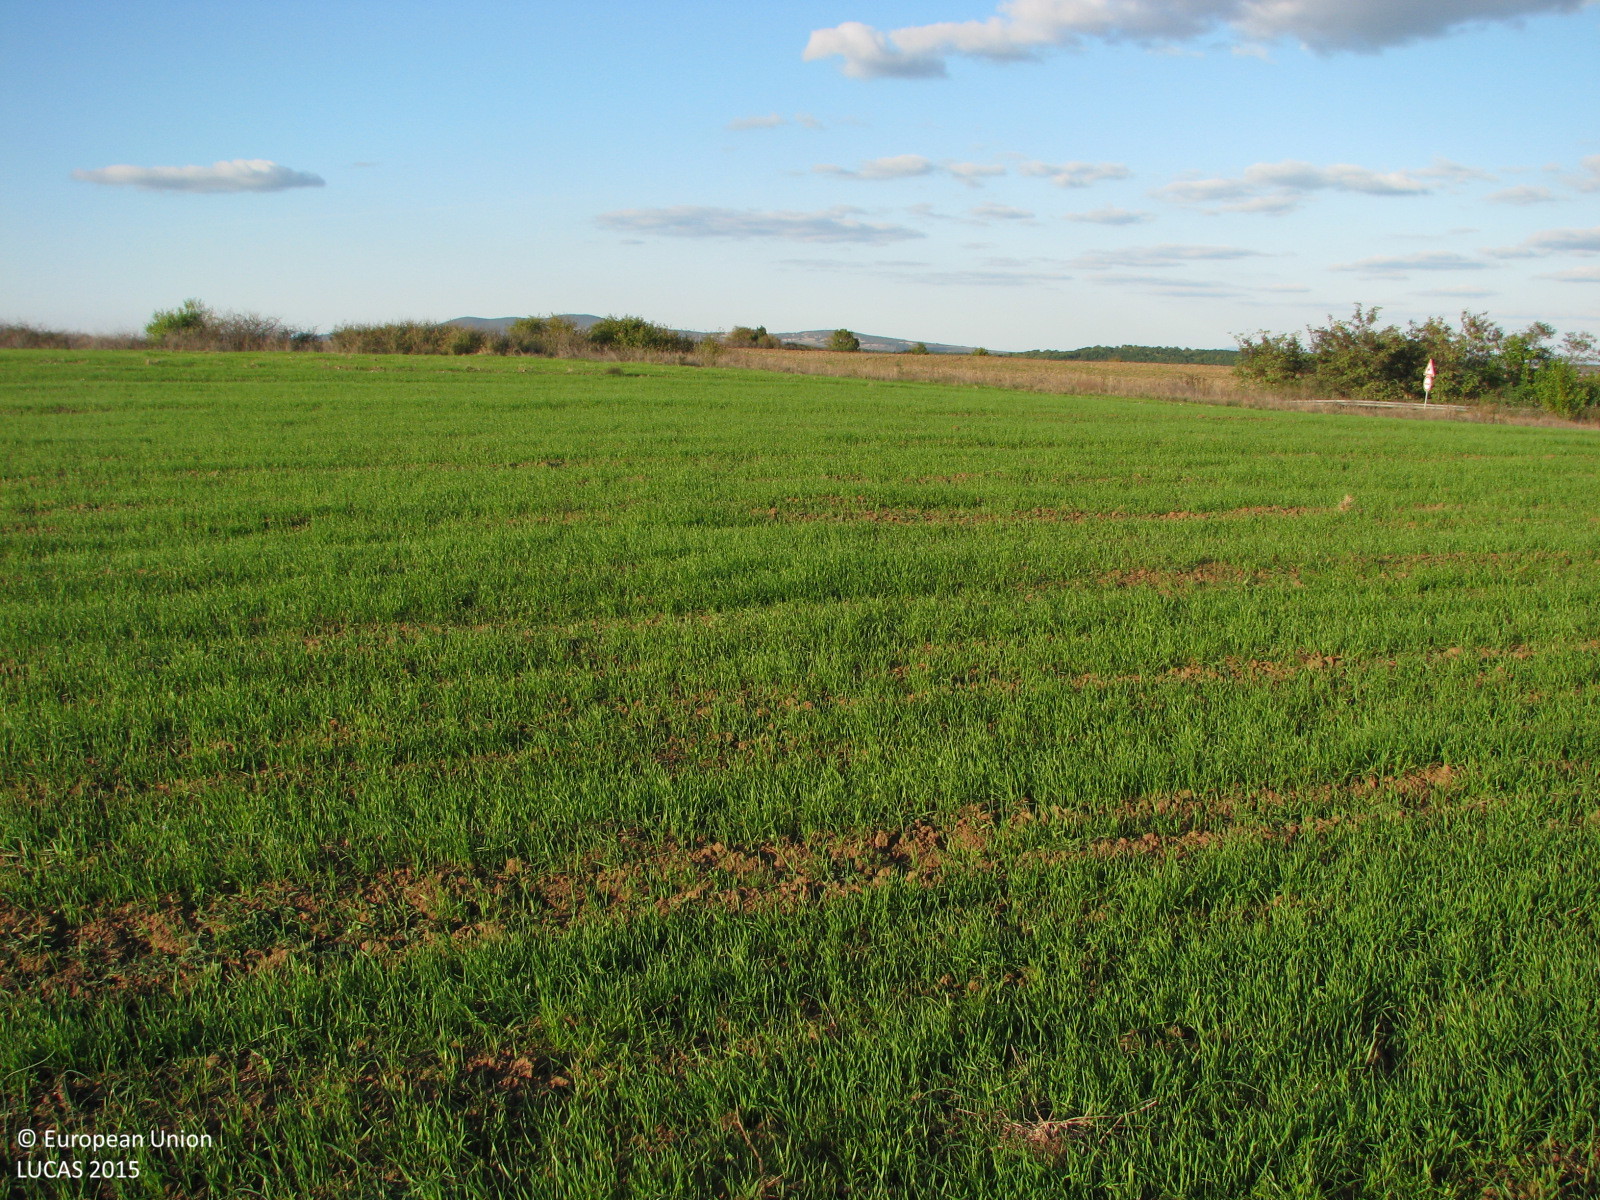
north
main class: Cropland
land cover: Common wheat
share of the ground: 50 - 75 %
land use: Agriculture (excluding fallow land and kitchen gardens)
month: October
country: BG
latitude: 42.1157
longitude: 26.4007
